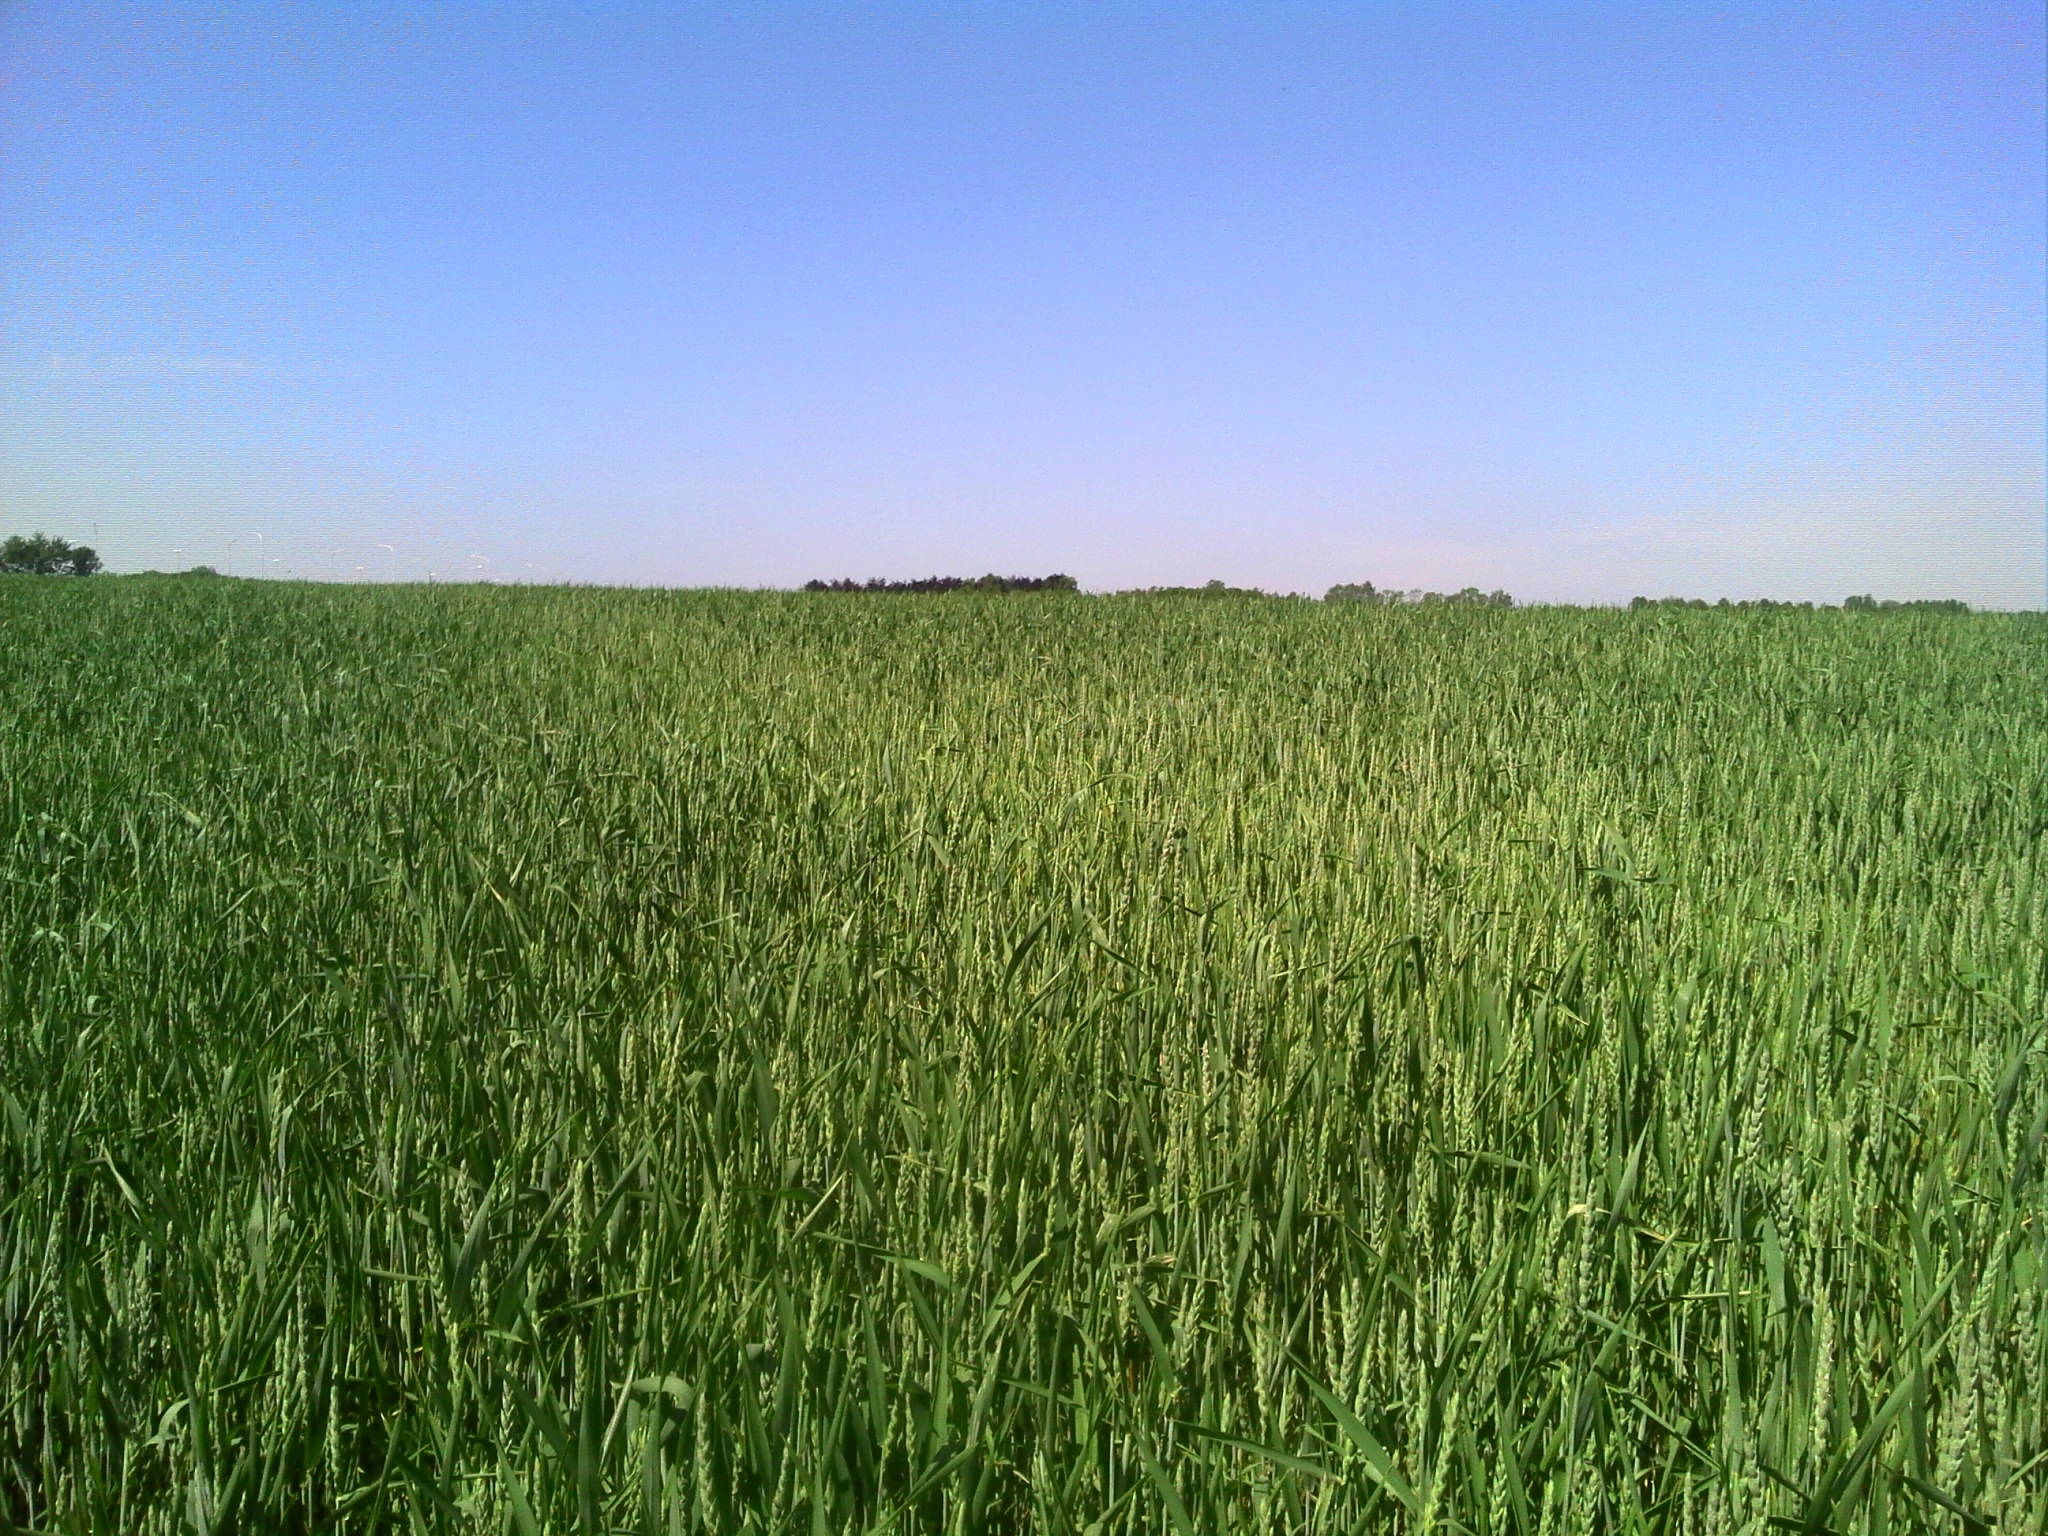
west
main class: Cropland
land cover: Common wheat
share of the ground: > 75 %
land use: Agriculture (excluding fallow land and kitchen gardens)
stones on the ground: < 10 %
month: June
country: BE
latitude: 50.4978
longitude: 4.7946
